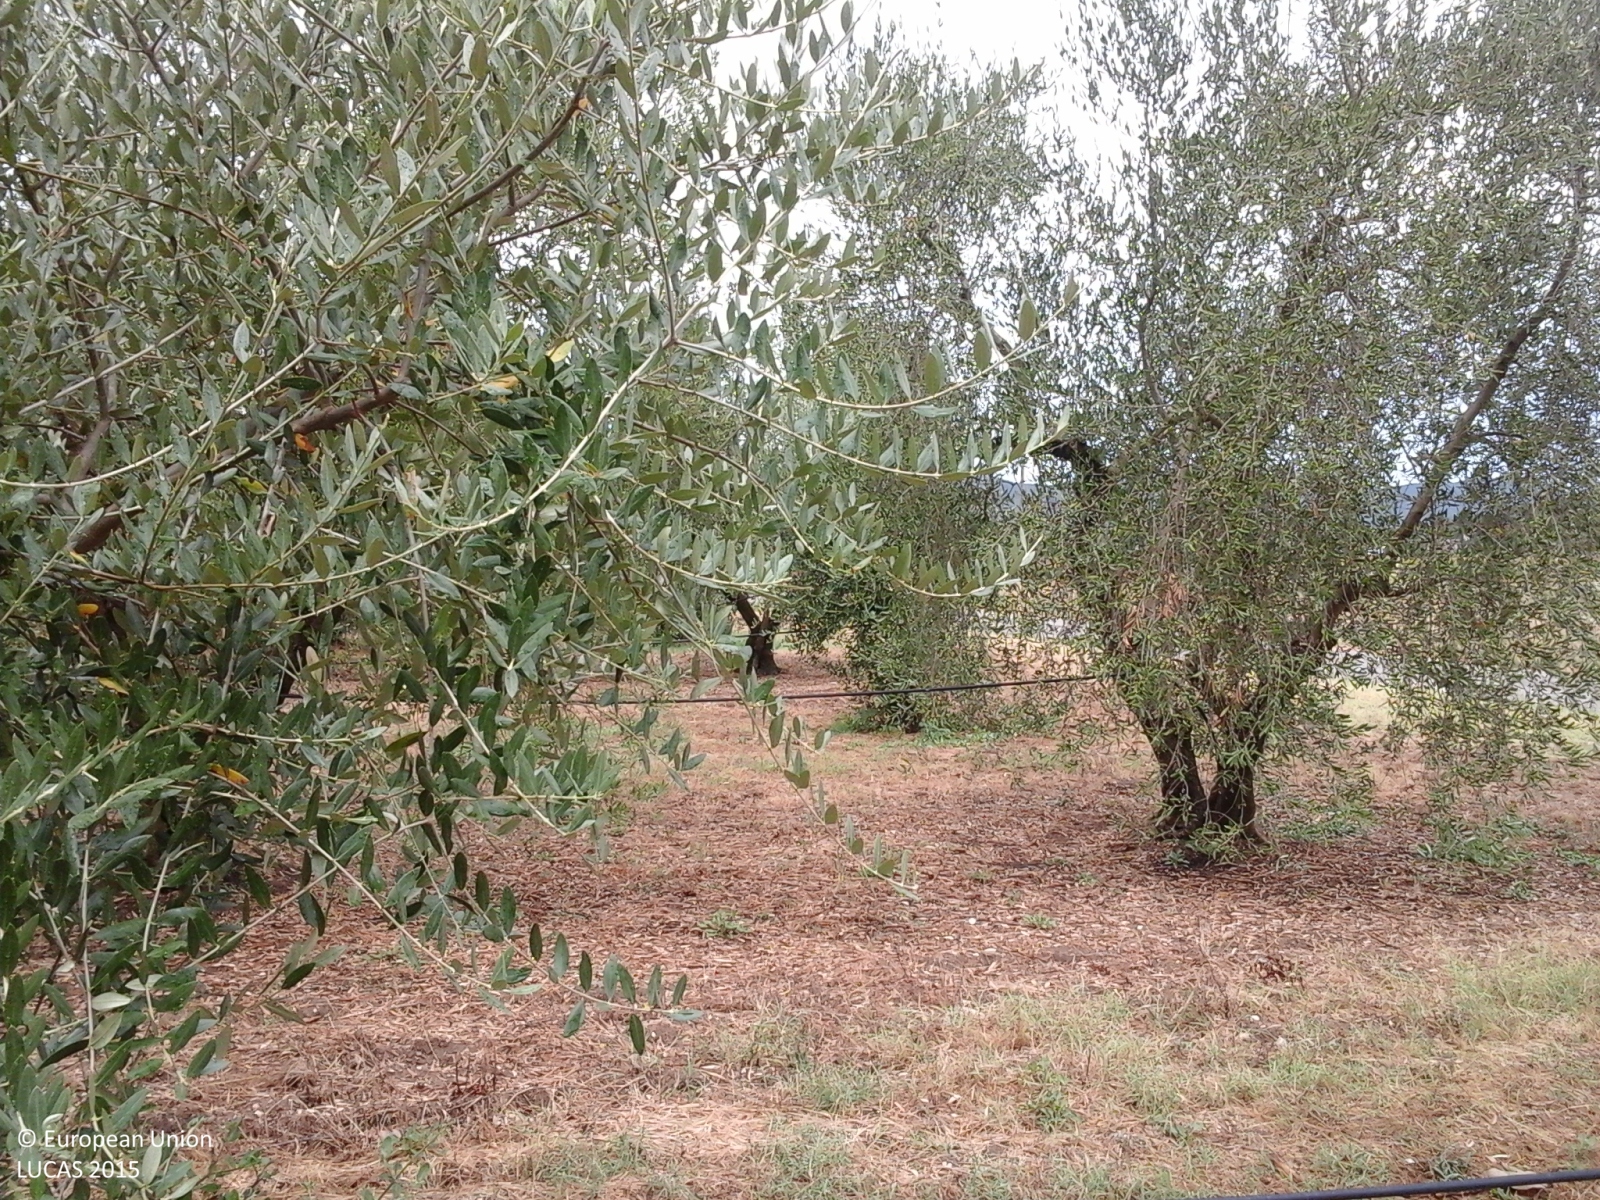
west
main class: Cropland
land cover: Olive groves
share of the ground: 50 - 75 %
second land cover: Grassland without tree/shrub cover
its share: 10 - 25 %
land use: Agriculture (excluding fallow land and kitchen gardens)
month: August
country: IT
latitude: 42.8840
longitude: 10.9886
